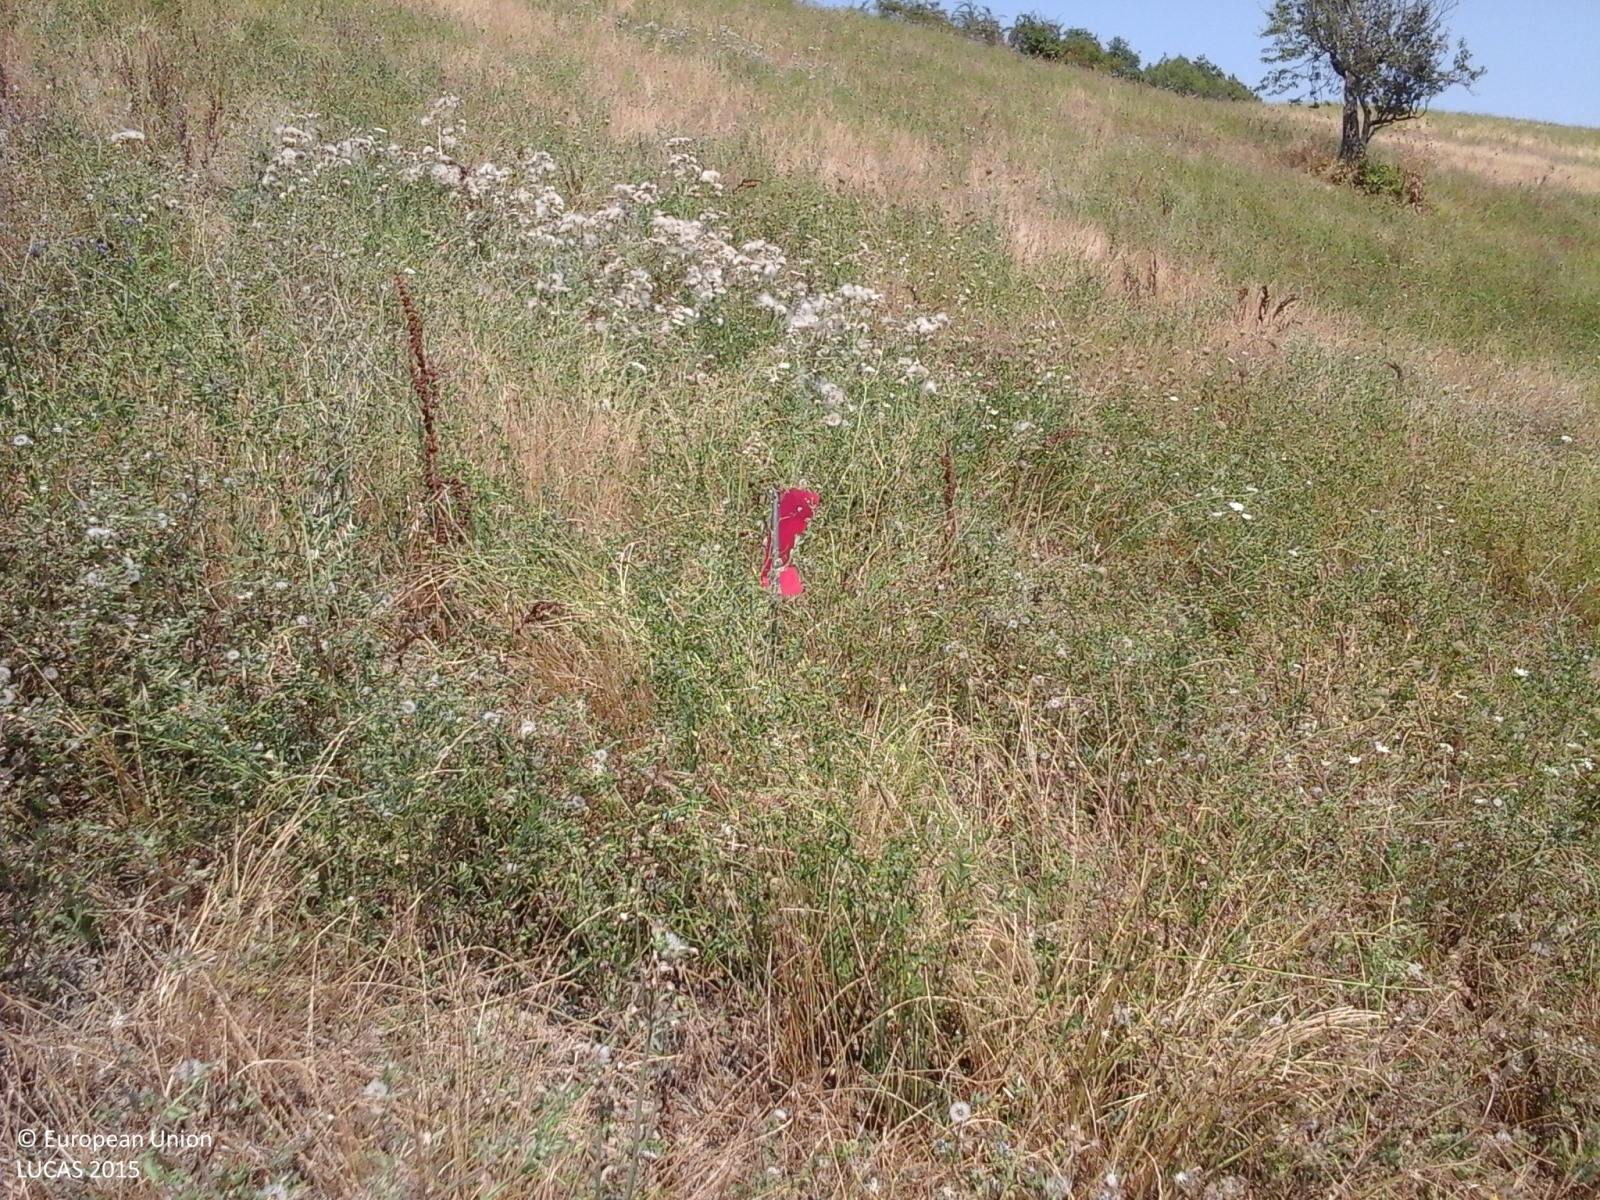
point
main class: Grassland
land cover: Spontaneously vegetated surfaces
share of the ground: > 75 %
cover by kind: herbaceous plants 100 %
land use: Fallow land
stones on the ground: < 10 %
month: August
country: IT
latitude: 43.7461
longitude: 12.3659
